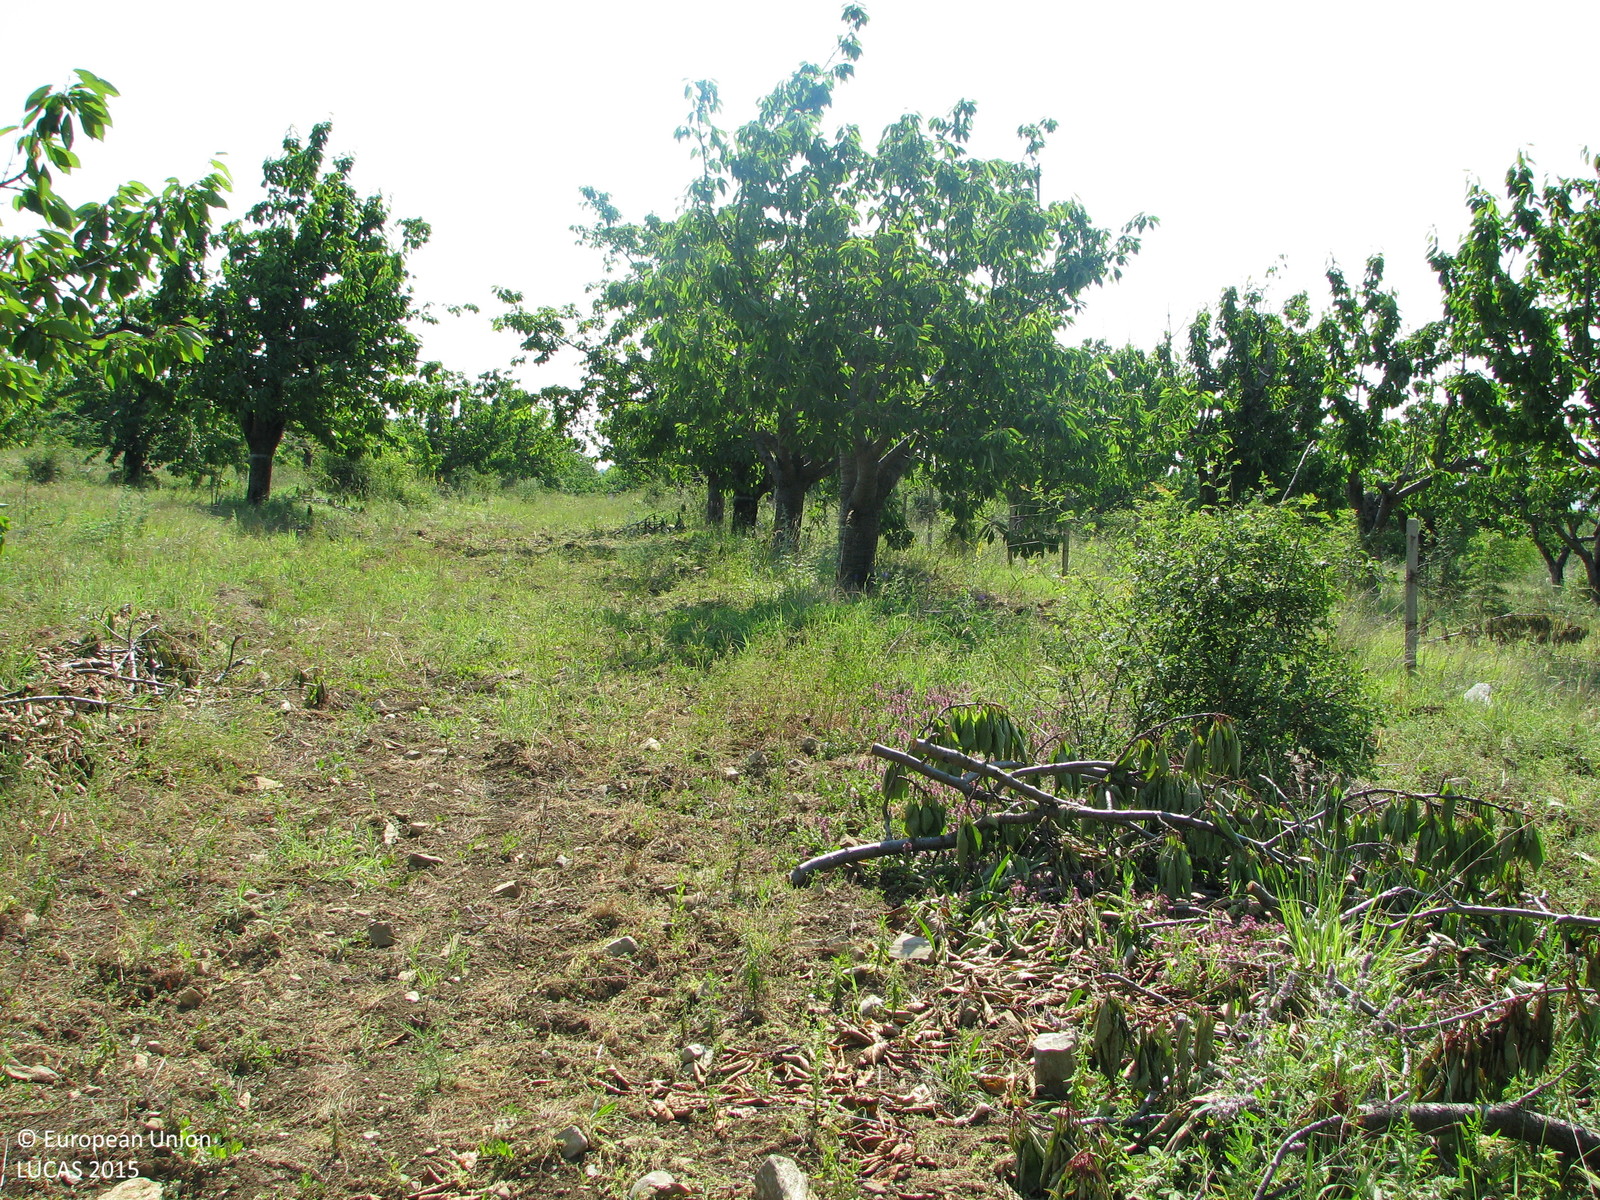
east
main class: Cropland
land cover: Cherry fruit
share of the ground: 25 - 50 %
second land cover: Spontaneously vegetated surfaces
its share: > 75 %
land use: Agriculture (excluding fallow land and kitchen gardens)
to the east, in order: Cherry fruit; Spontaneously vegetated surfaces; Lines of trees; Paved roads, cycling and walking lanes; Lines of trees; Grass margins; Fences; Cherry fruit
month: June
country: BG
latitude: 42.6449
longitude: 26.1990
